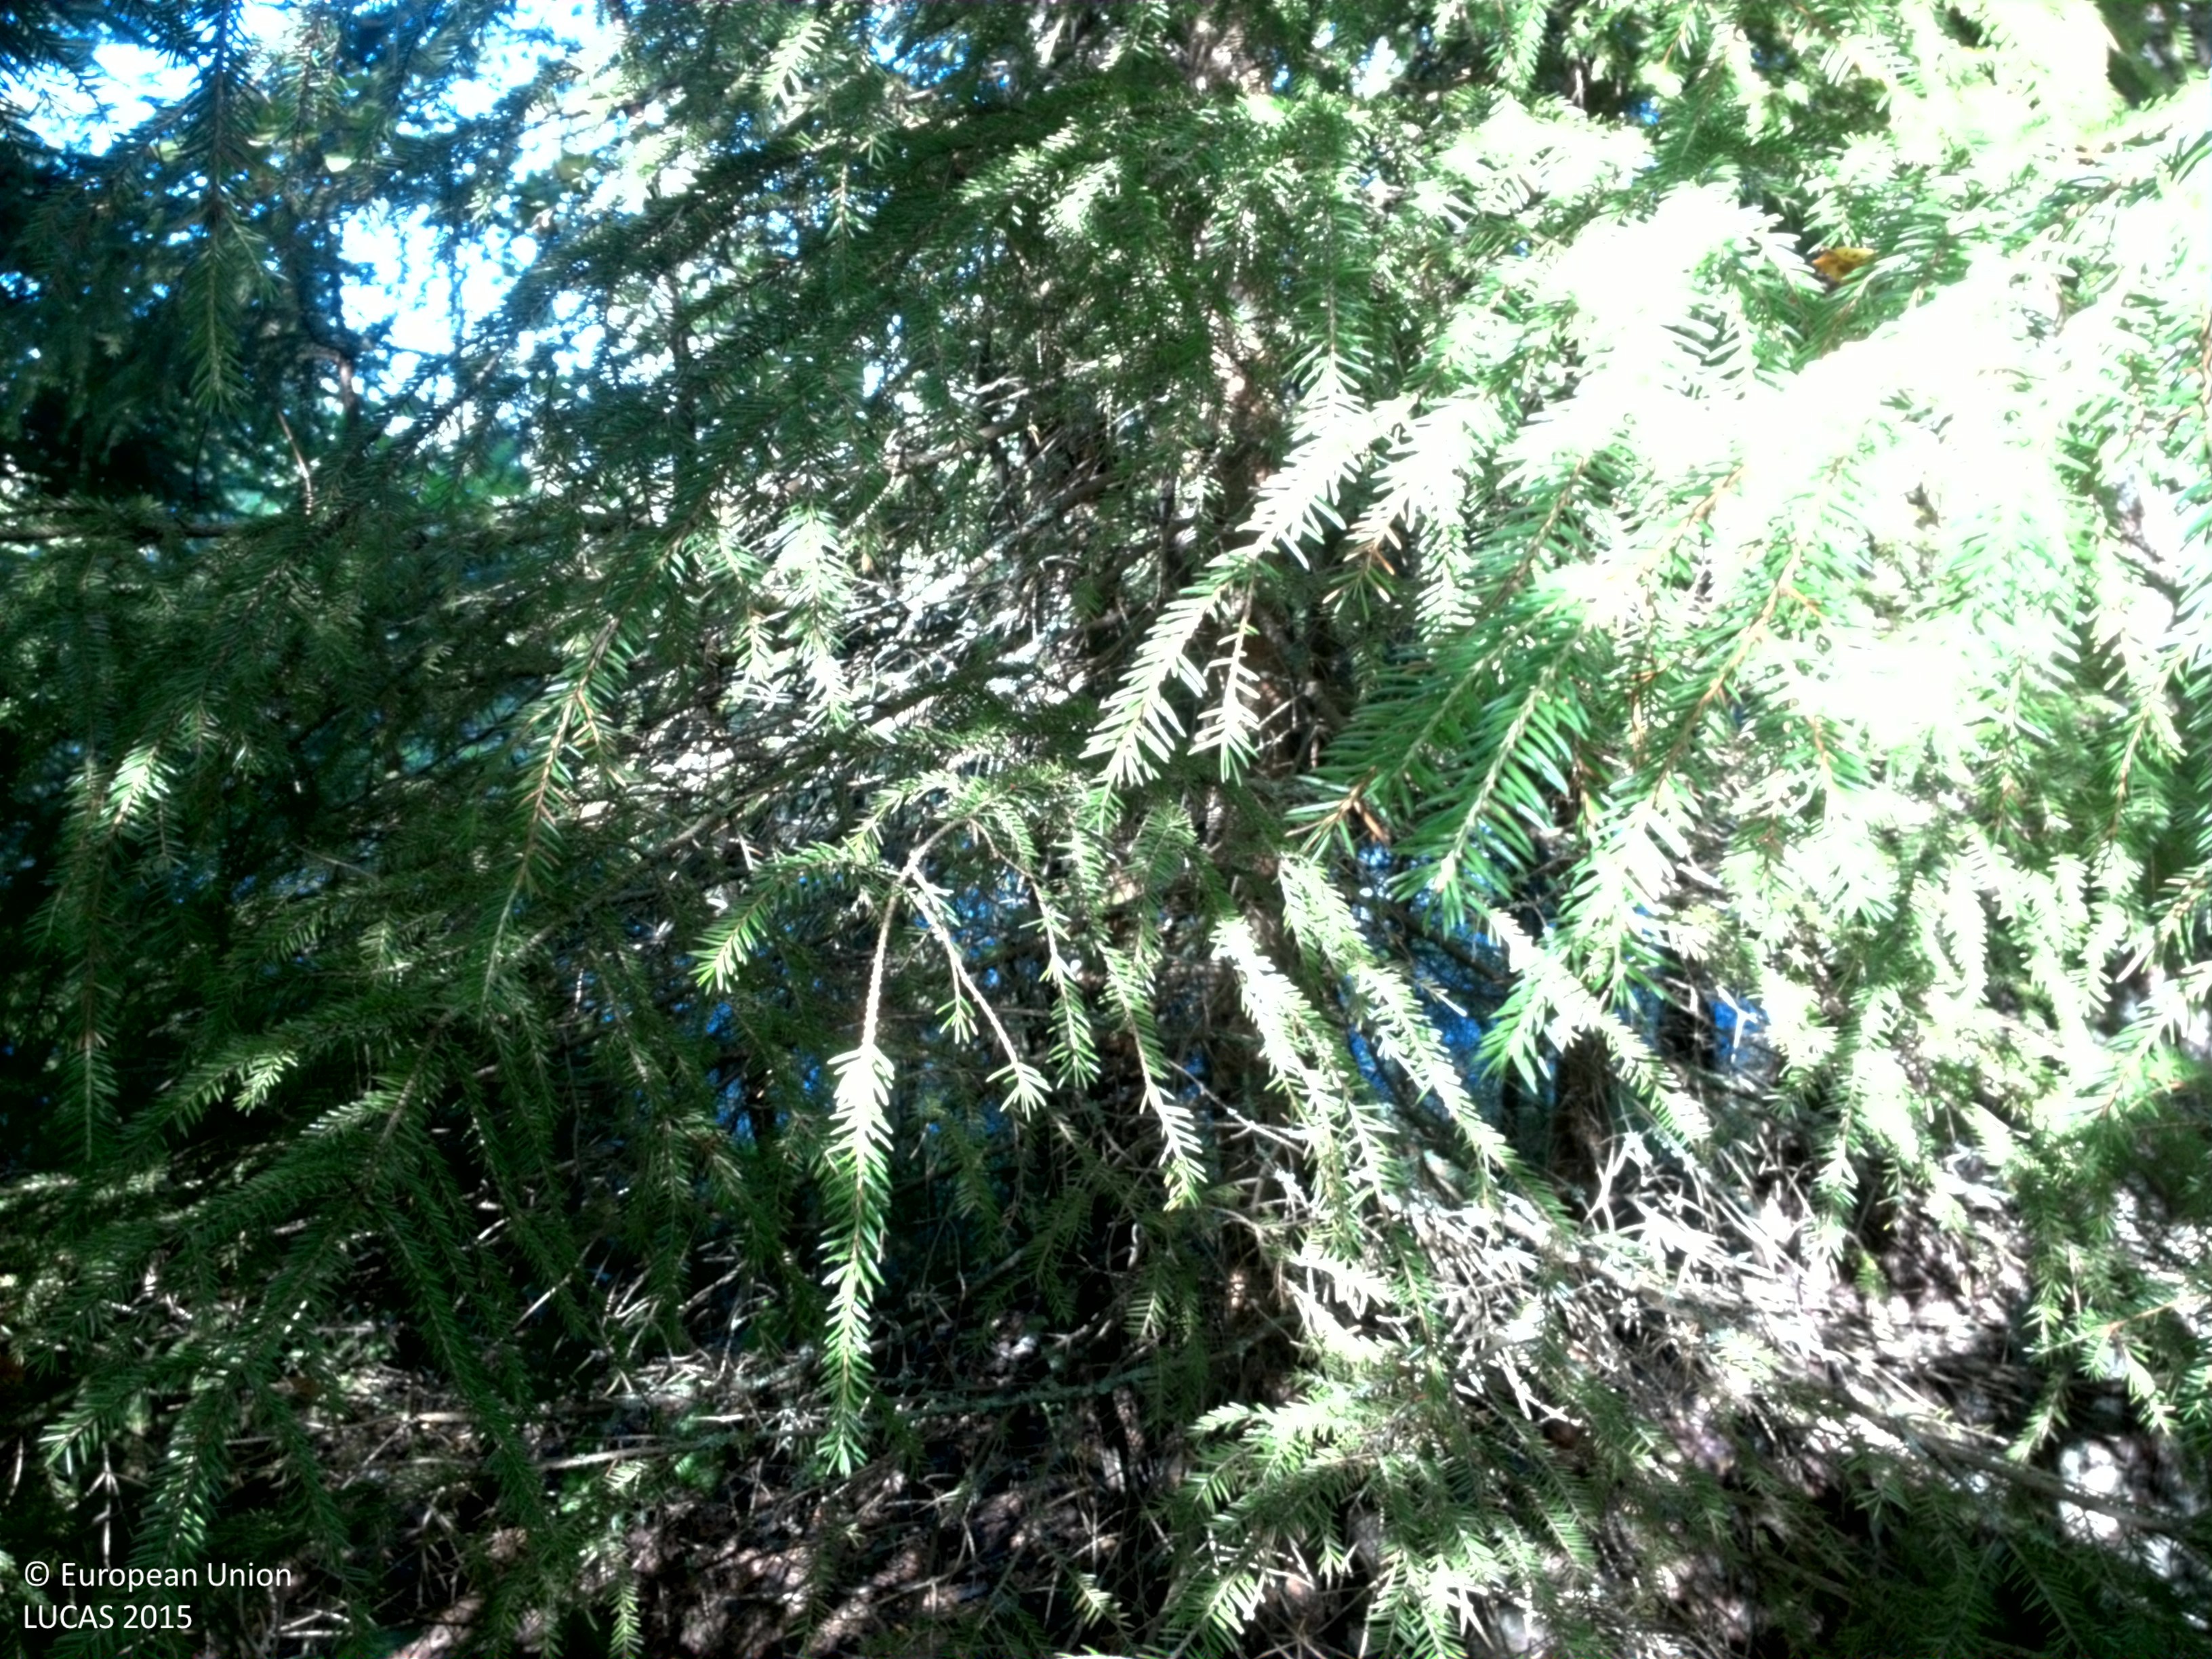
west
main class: Woodland
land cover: Spruce dominated mixed woodland
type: boreal forest
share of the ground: > 75 %
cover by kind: coniferous forest trees 50 %, broadleaved forest trees 35 %, shrubs 5 %, herbaceous plants 5 %, lichens and mosses 5 %
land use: Forestry
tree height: > 5 m
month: August
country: SE
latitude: 59.9950
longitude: 14.0954
